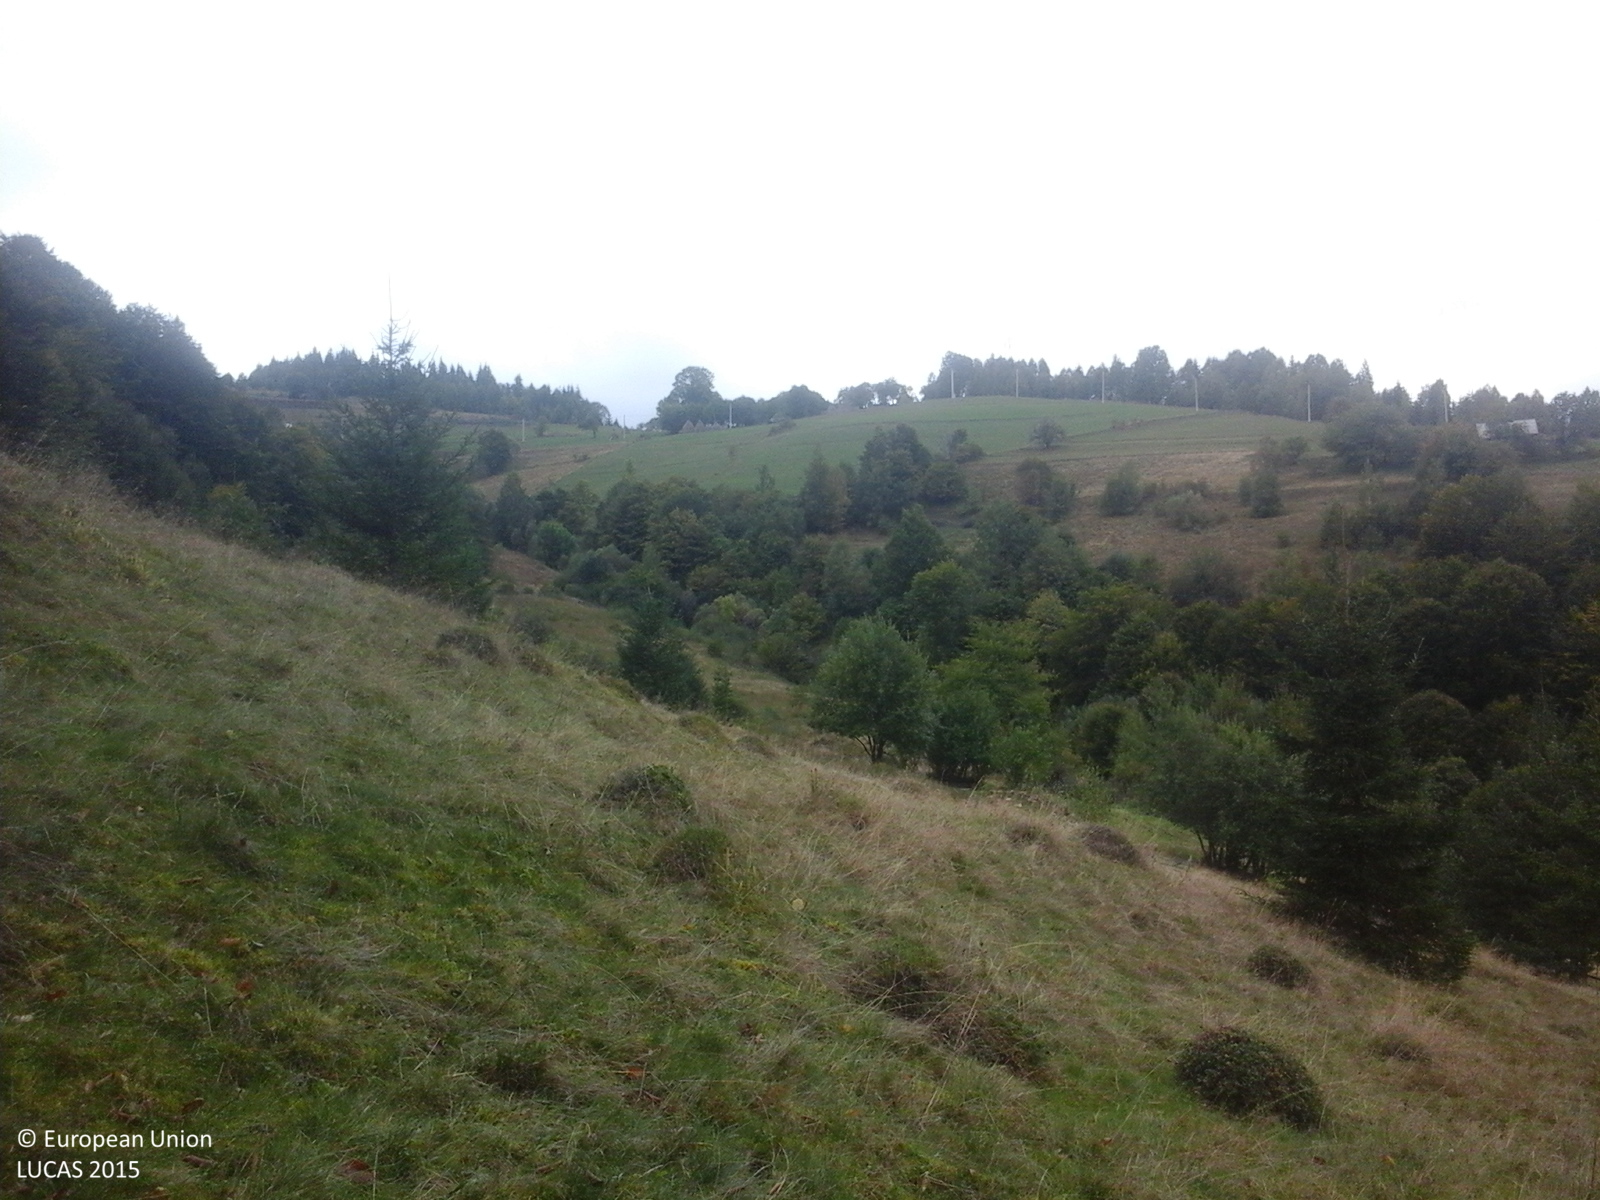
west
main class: Woodland
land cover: Other mixed woodland
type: beech forest
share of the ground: > 75 %
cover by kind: herbaceous plants 40 %, broadleaved forest trees 35 %, coniferous forest trees 25 %
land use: Forestry
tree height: > 5 m
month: September
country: RO
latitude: 46.6979
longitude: 22.8879
